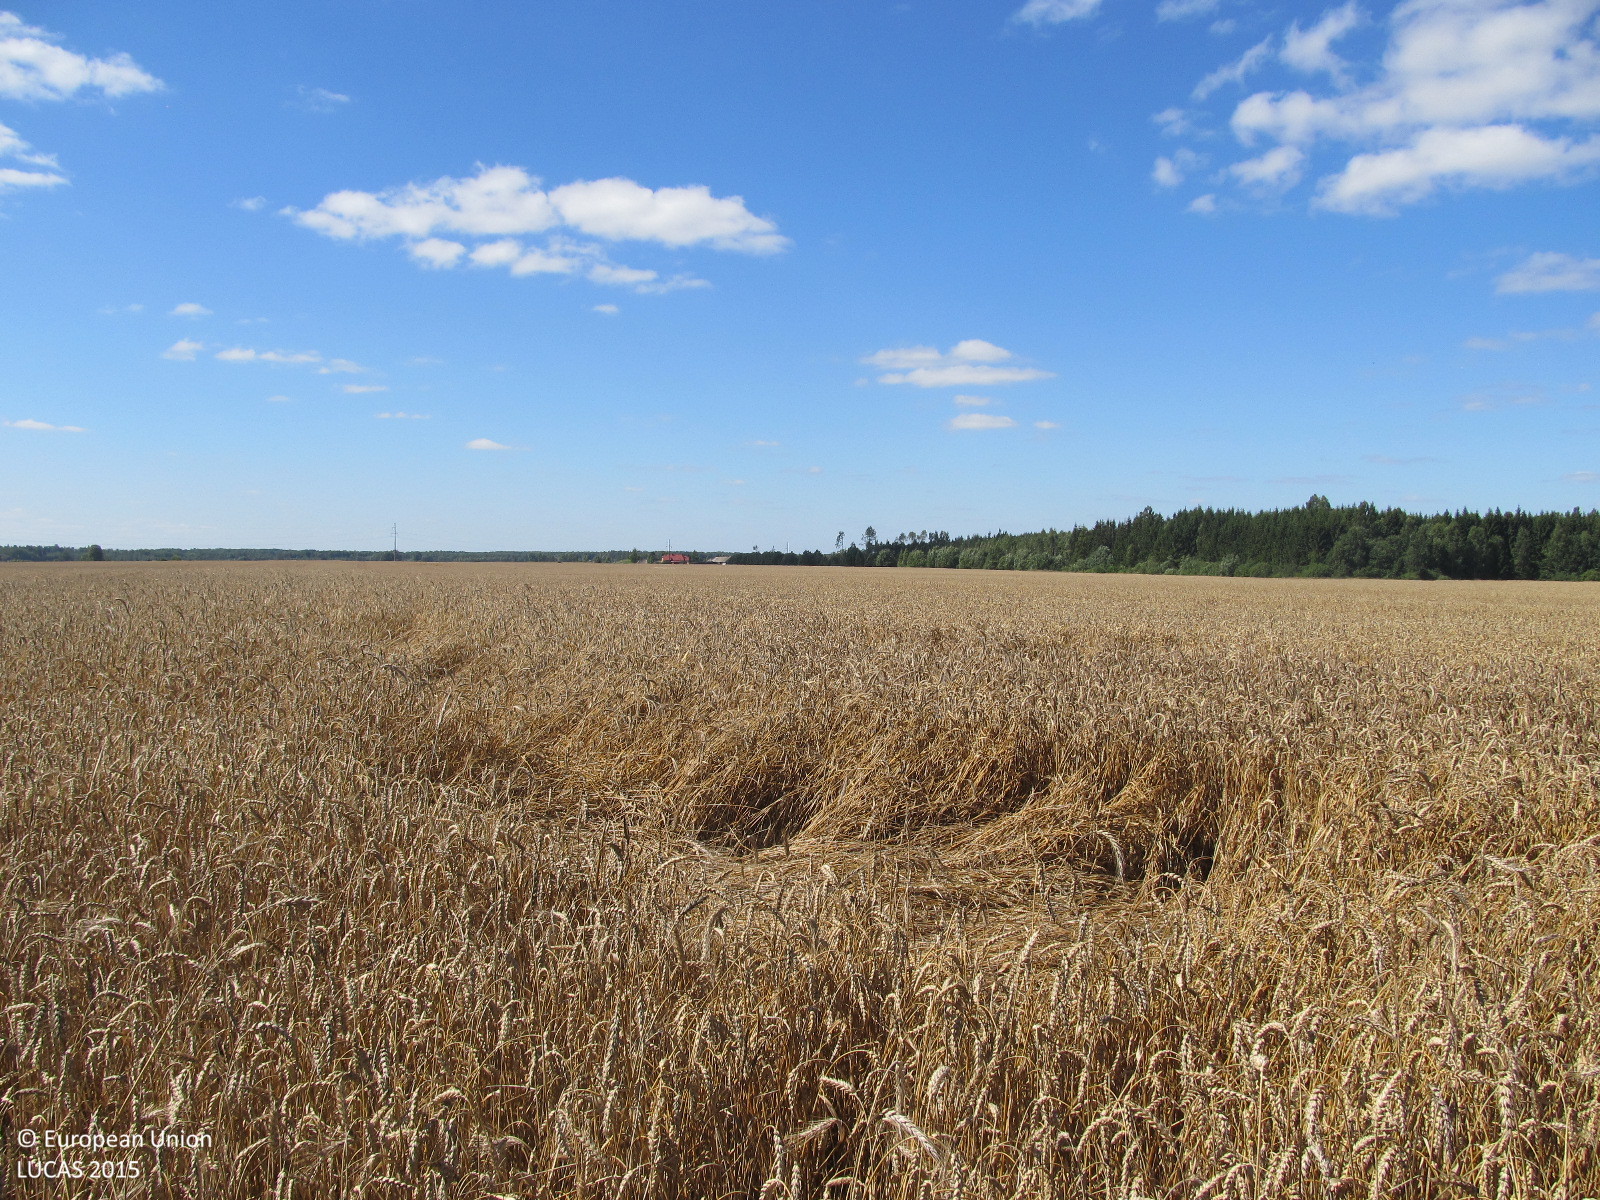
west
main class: Cropland
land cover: Common wheat
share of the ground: > 75 %
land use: Agriculture (excluding fallow land and kitchen gardens)
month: August
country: LT
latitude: 56.0829
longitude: 22.8724
